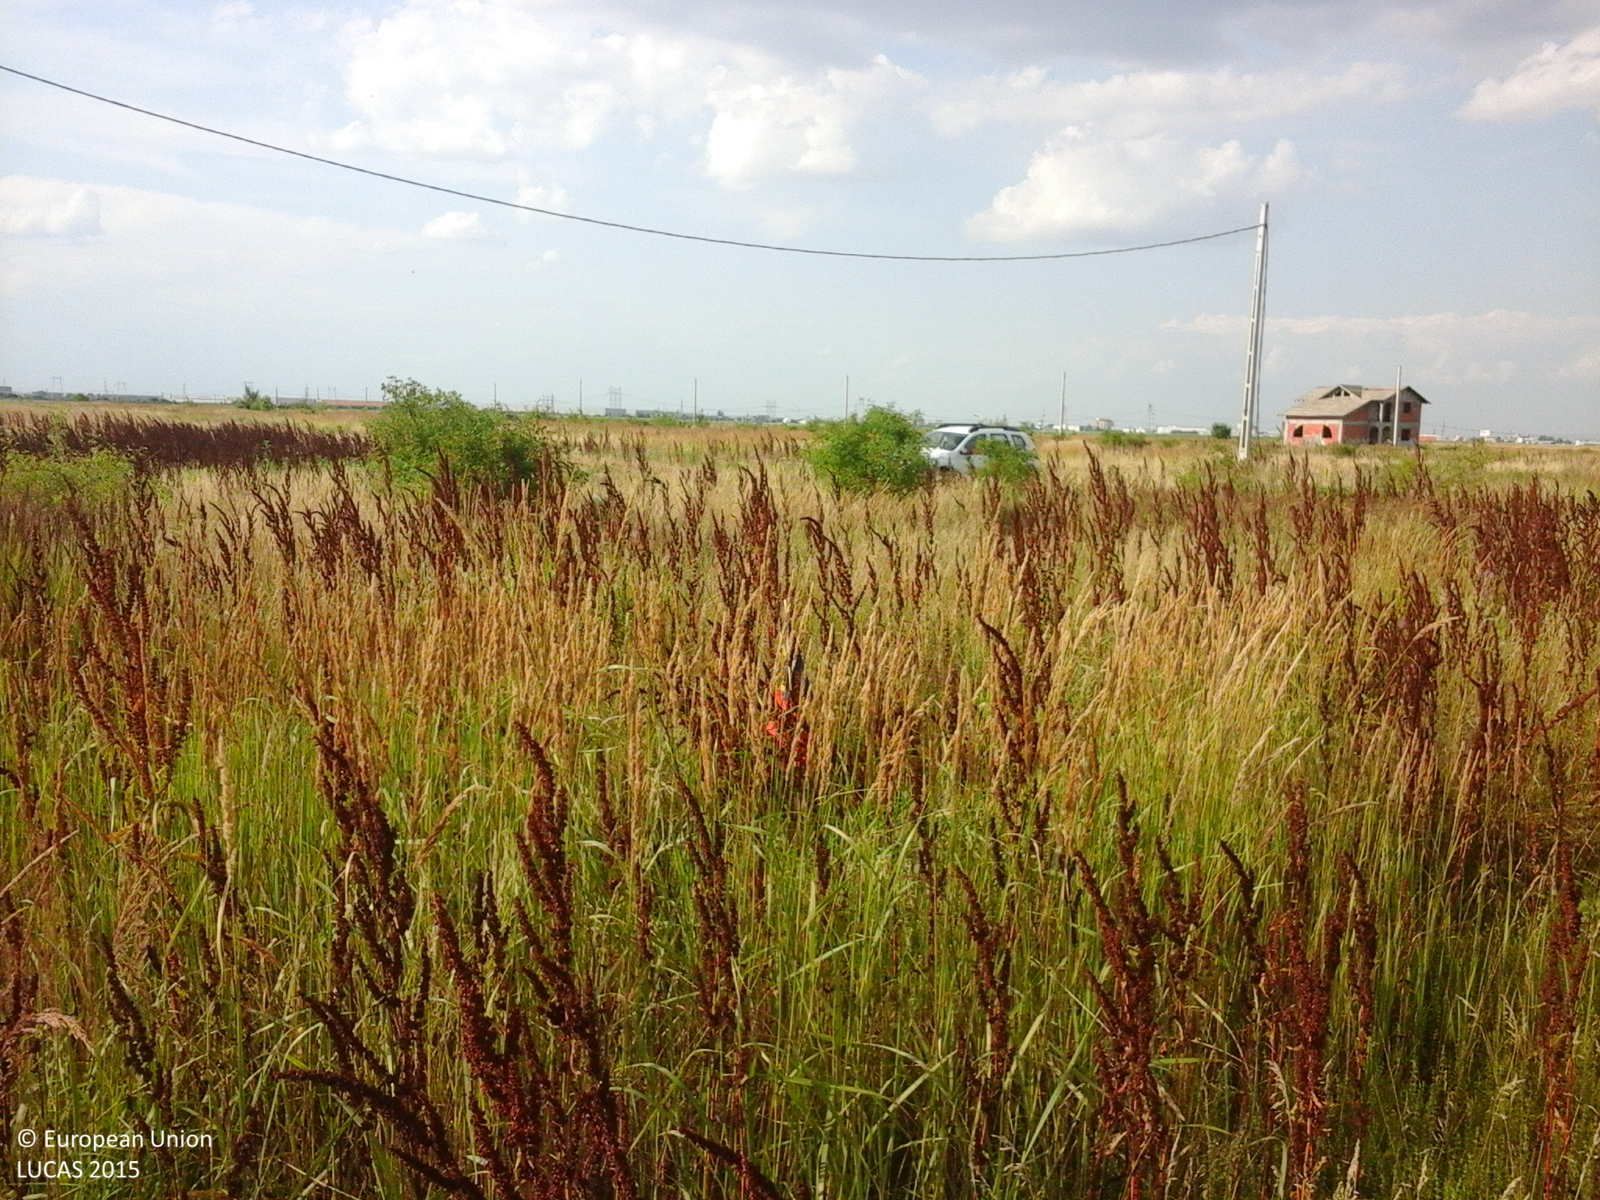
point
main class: Grassland
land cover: Spontaneously vegetated surfaces
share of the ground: > 75 %
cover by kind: herbaceous plants 100 %
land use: Semi-natural and natural areas not in use
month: June
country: RO
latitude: 44.4126
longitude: 25.9369
